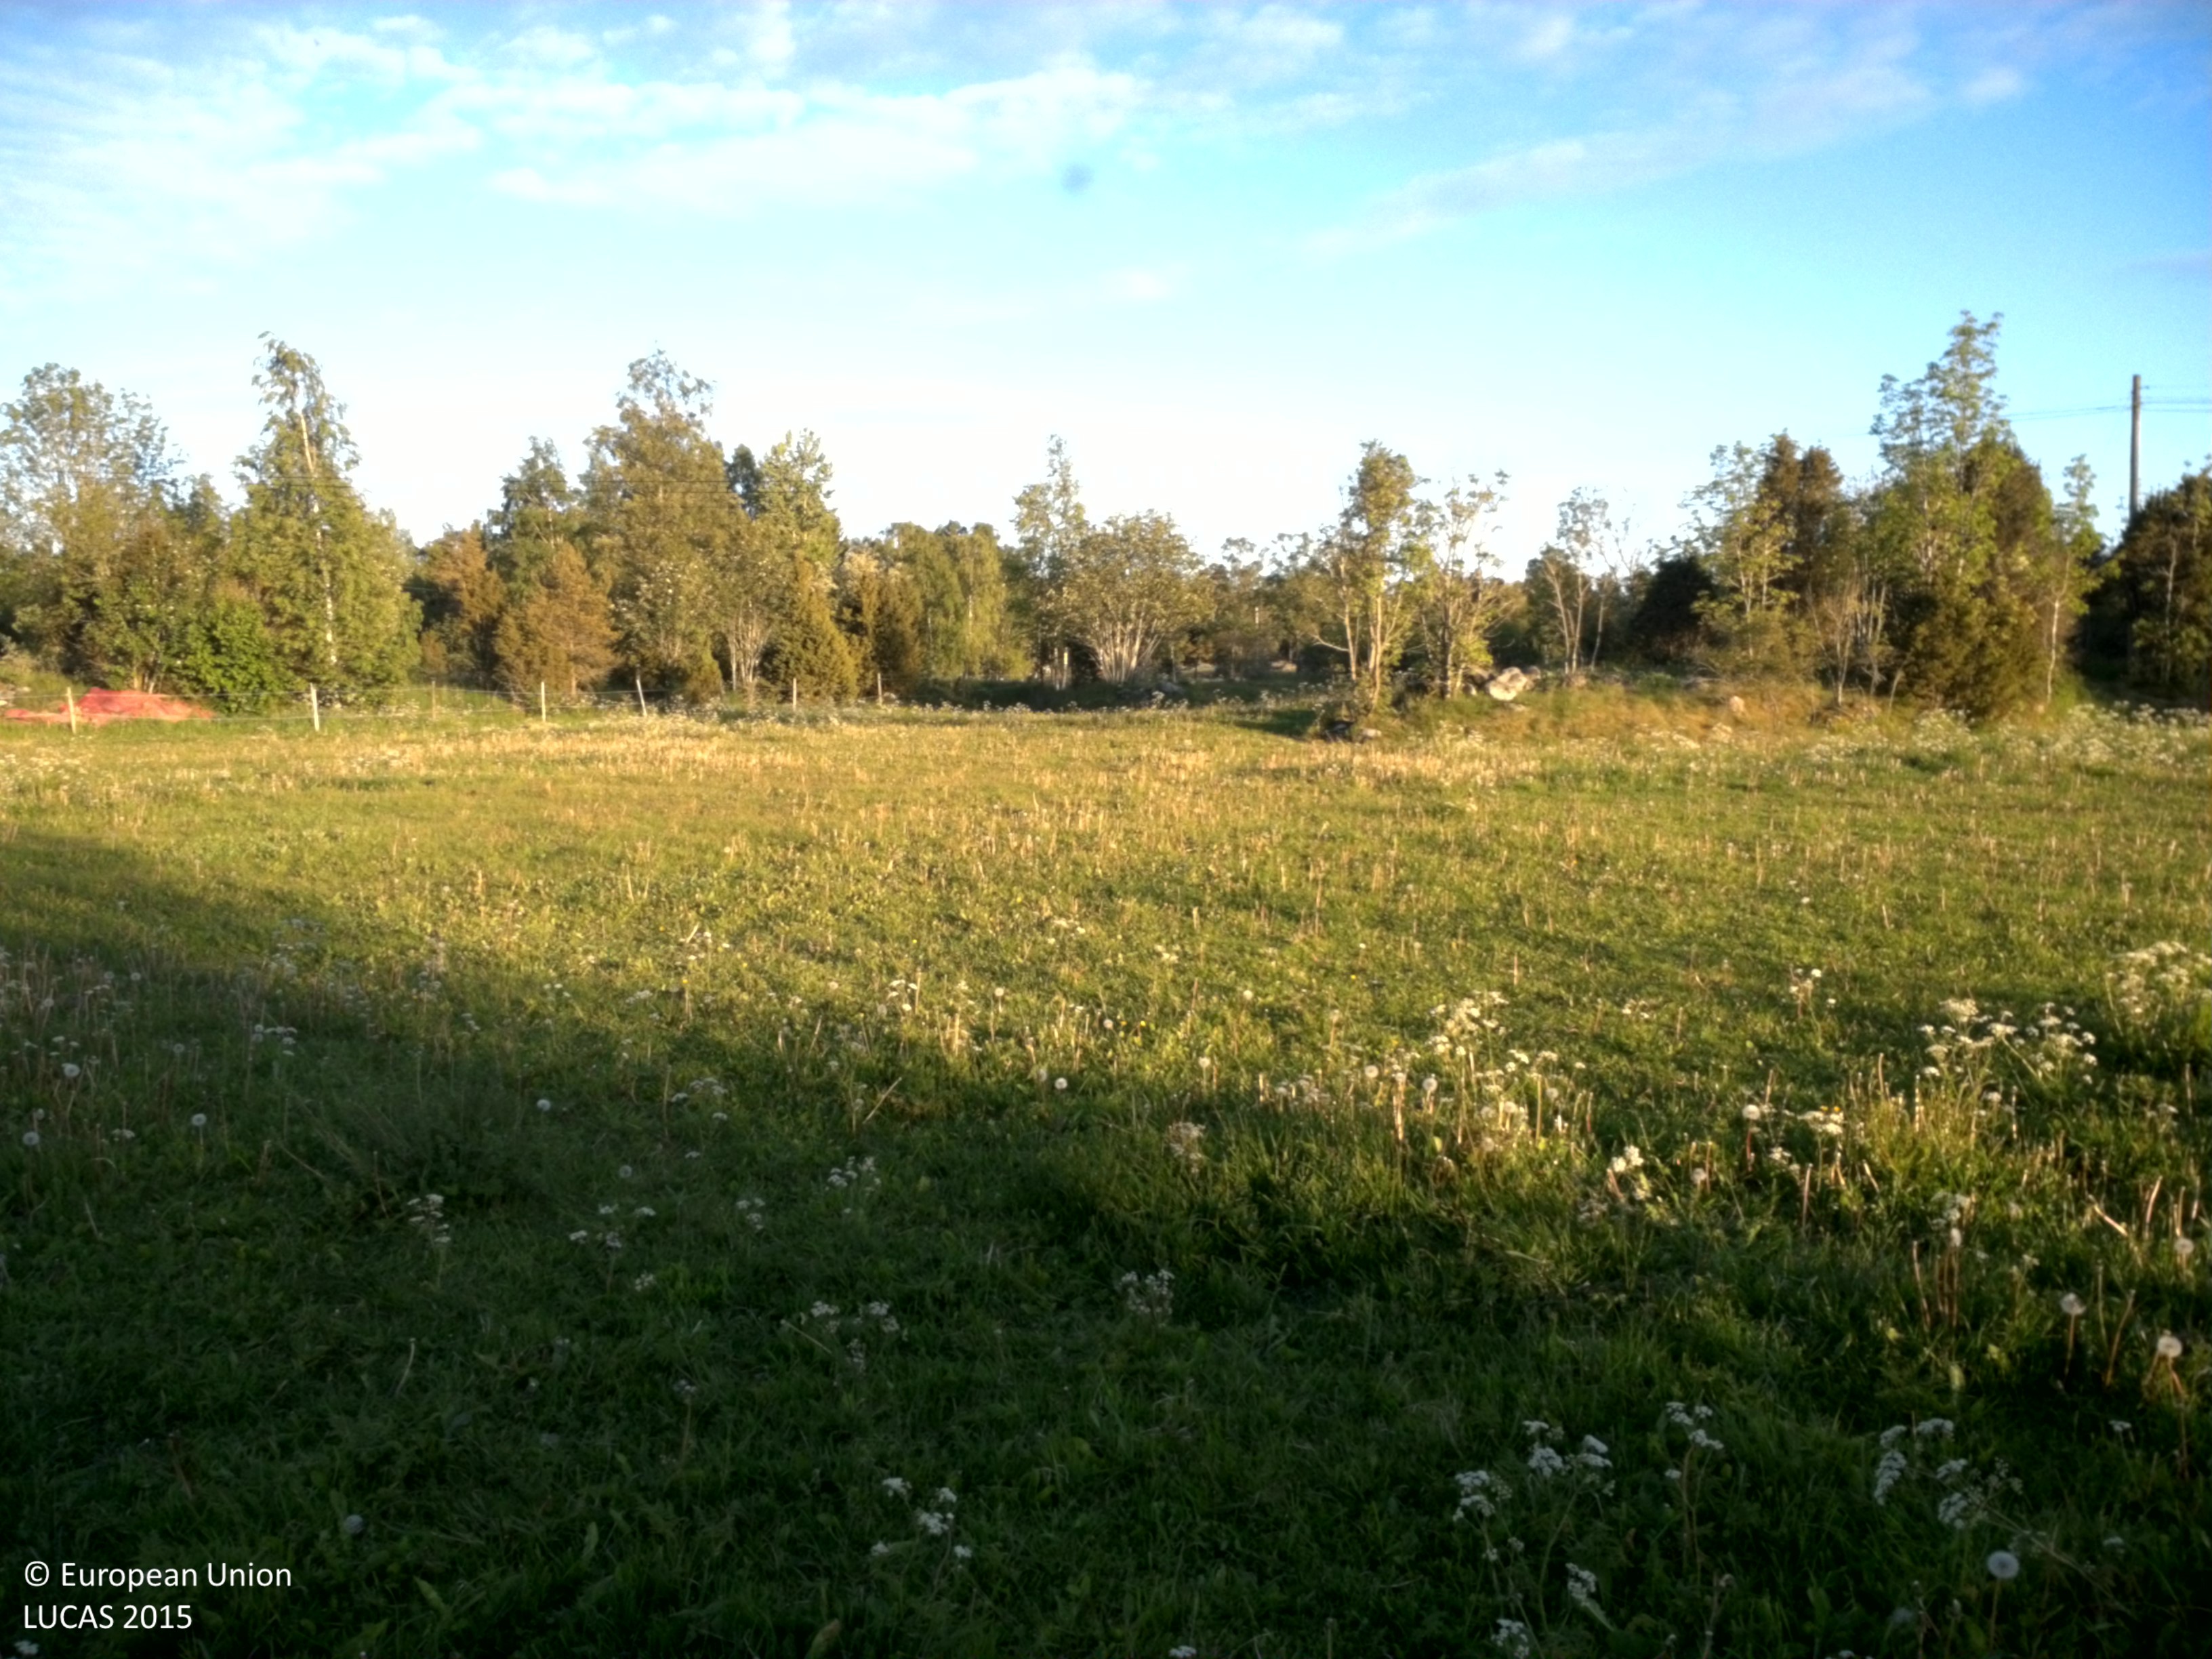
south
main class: Grassland
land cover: Grassland without tree/shrub cover
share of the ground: > 75 %
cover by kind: herbaceous plants 85 %, lichens and mosses 10 %, shrubs 5 %
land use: Agriculture (excluding fallow land and kitchen gardens)
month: June
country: SE
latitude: 60.1609
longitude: 18.7729
